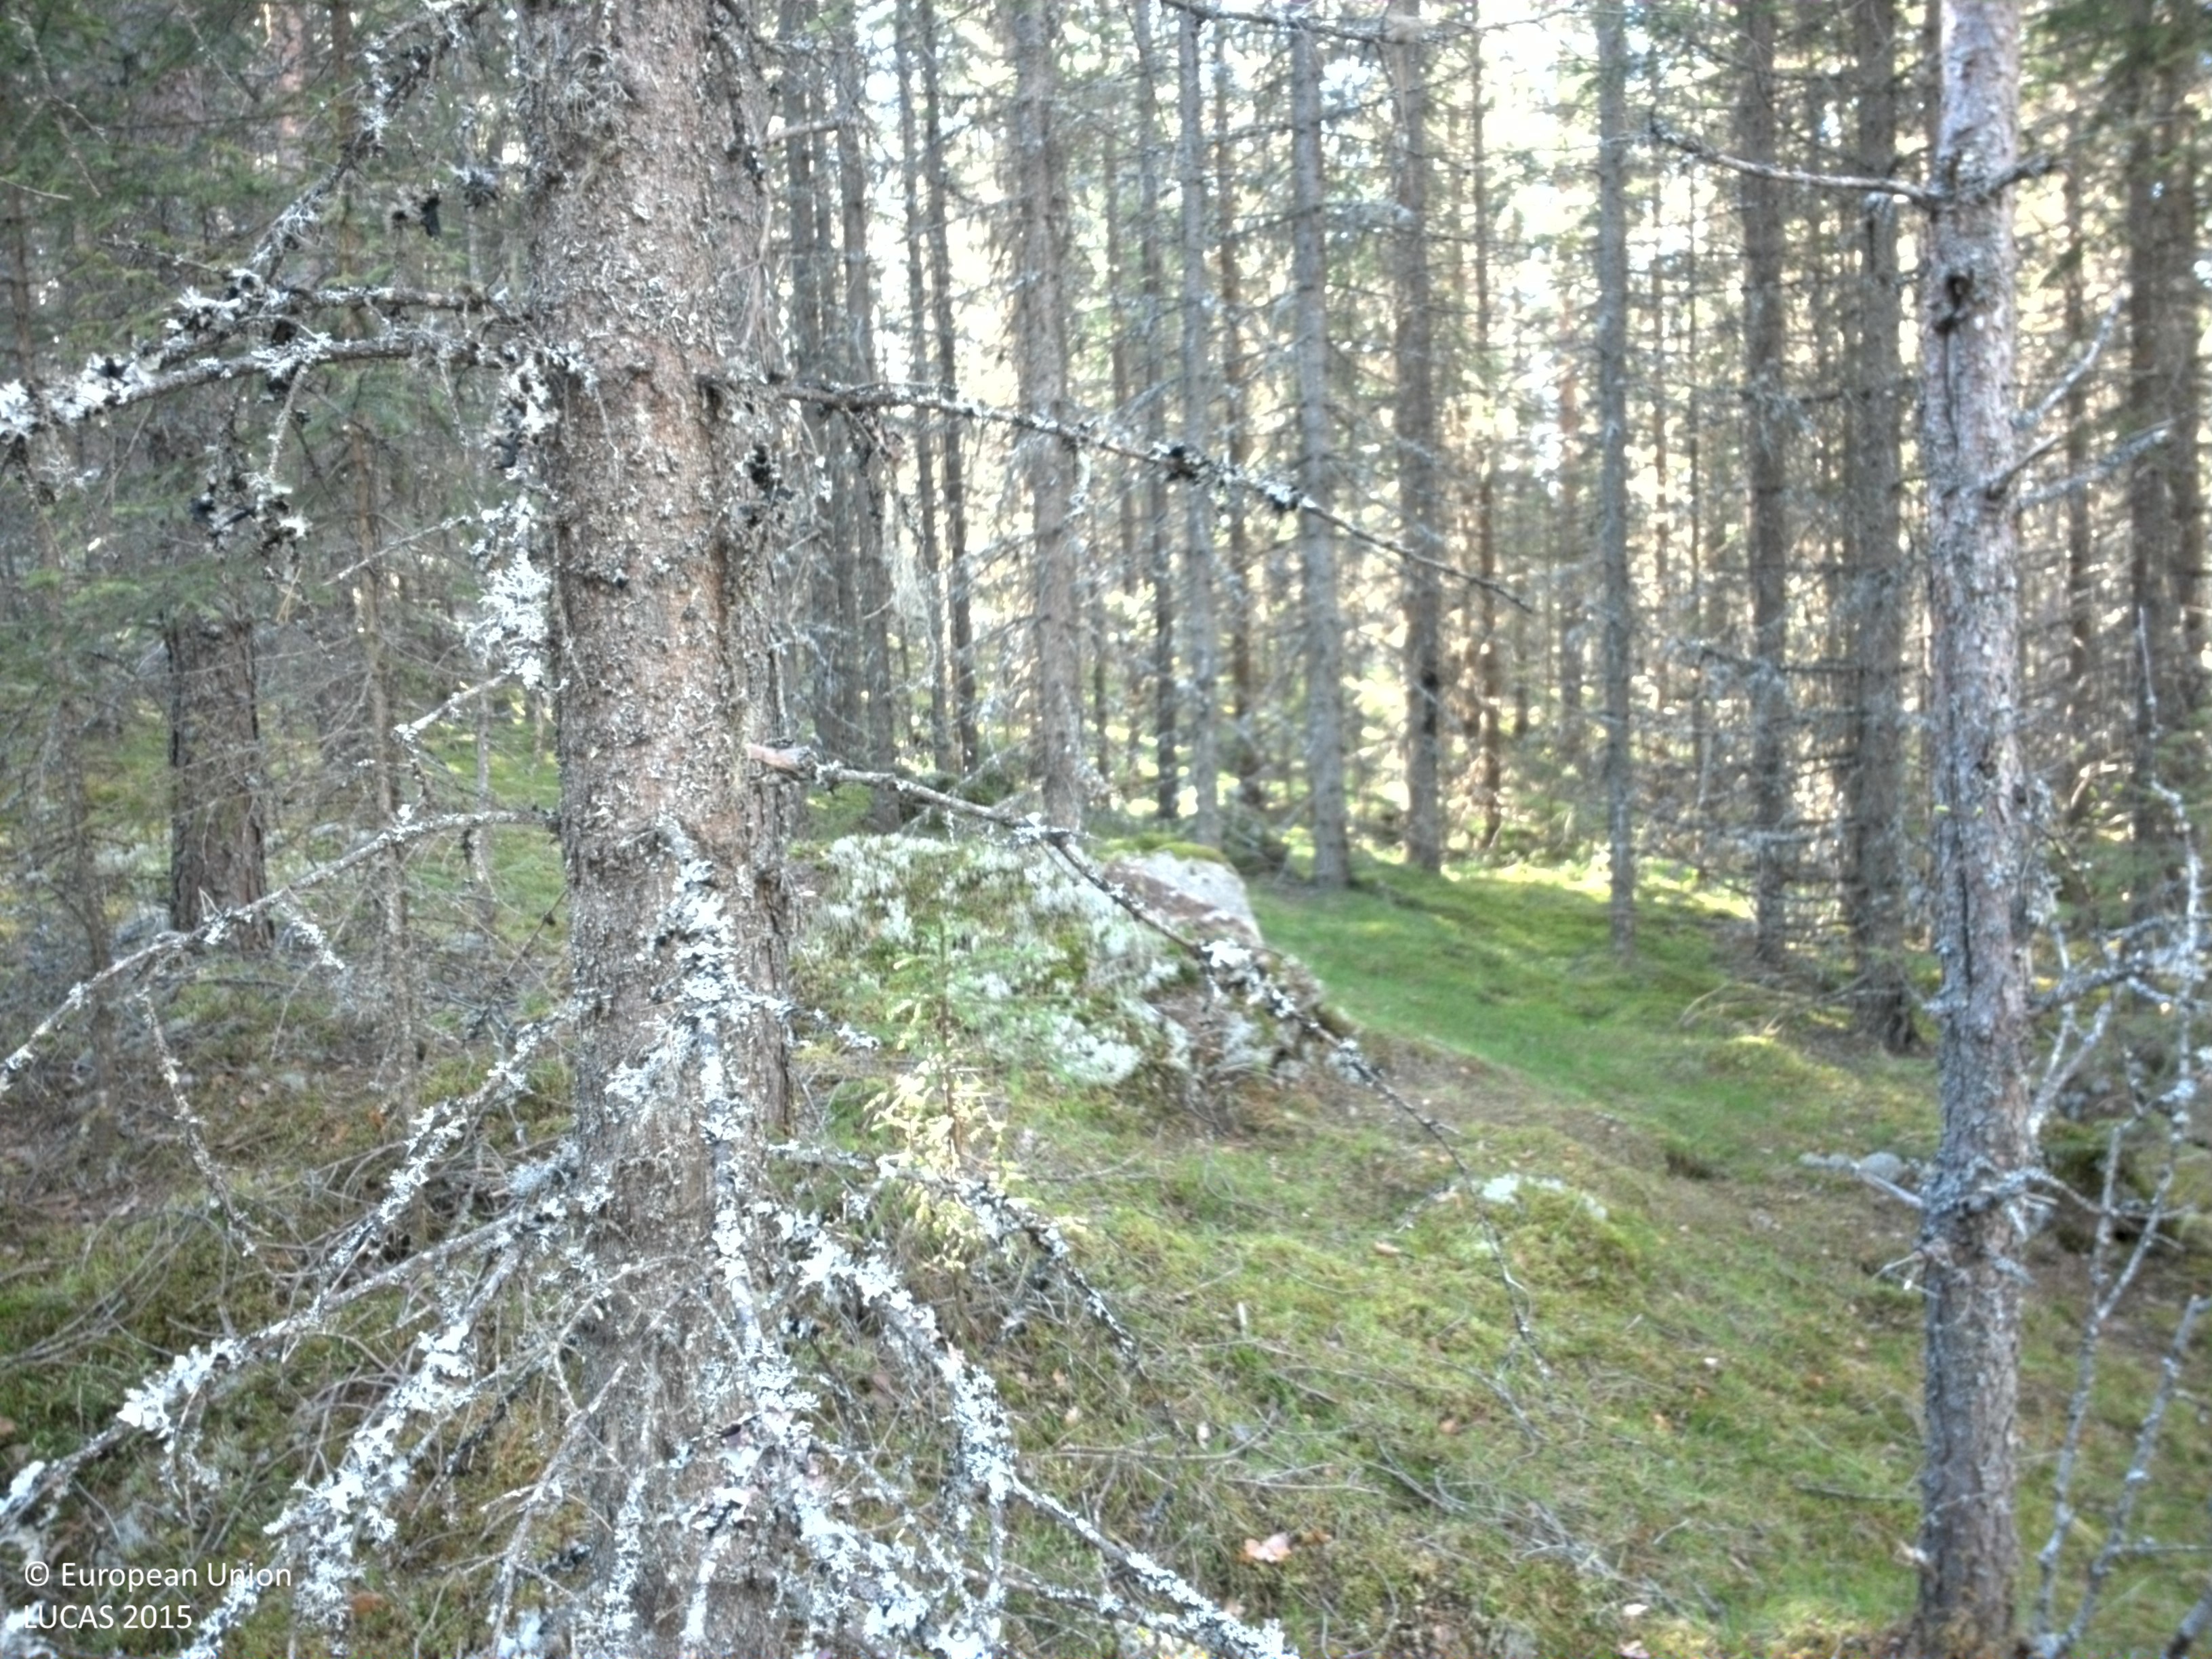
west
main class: Woodland
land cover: Spruce dominated mixed woodland
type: boreal forest
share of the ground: > 75 %
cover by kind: coniferous forest trees 65 %, broadleaved forest trees 25 %, shrubs 10 %
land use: Forestry
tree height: > 5 m
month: May
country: SE
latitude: 60.9706
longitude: 12.4116
